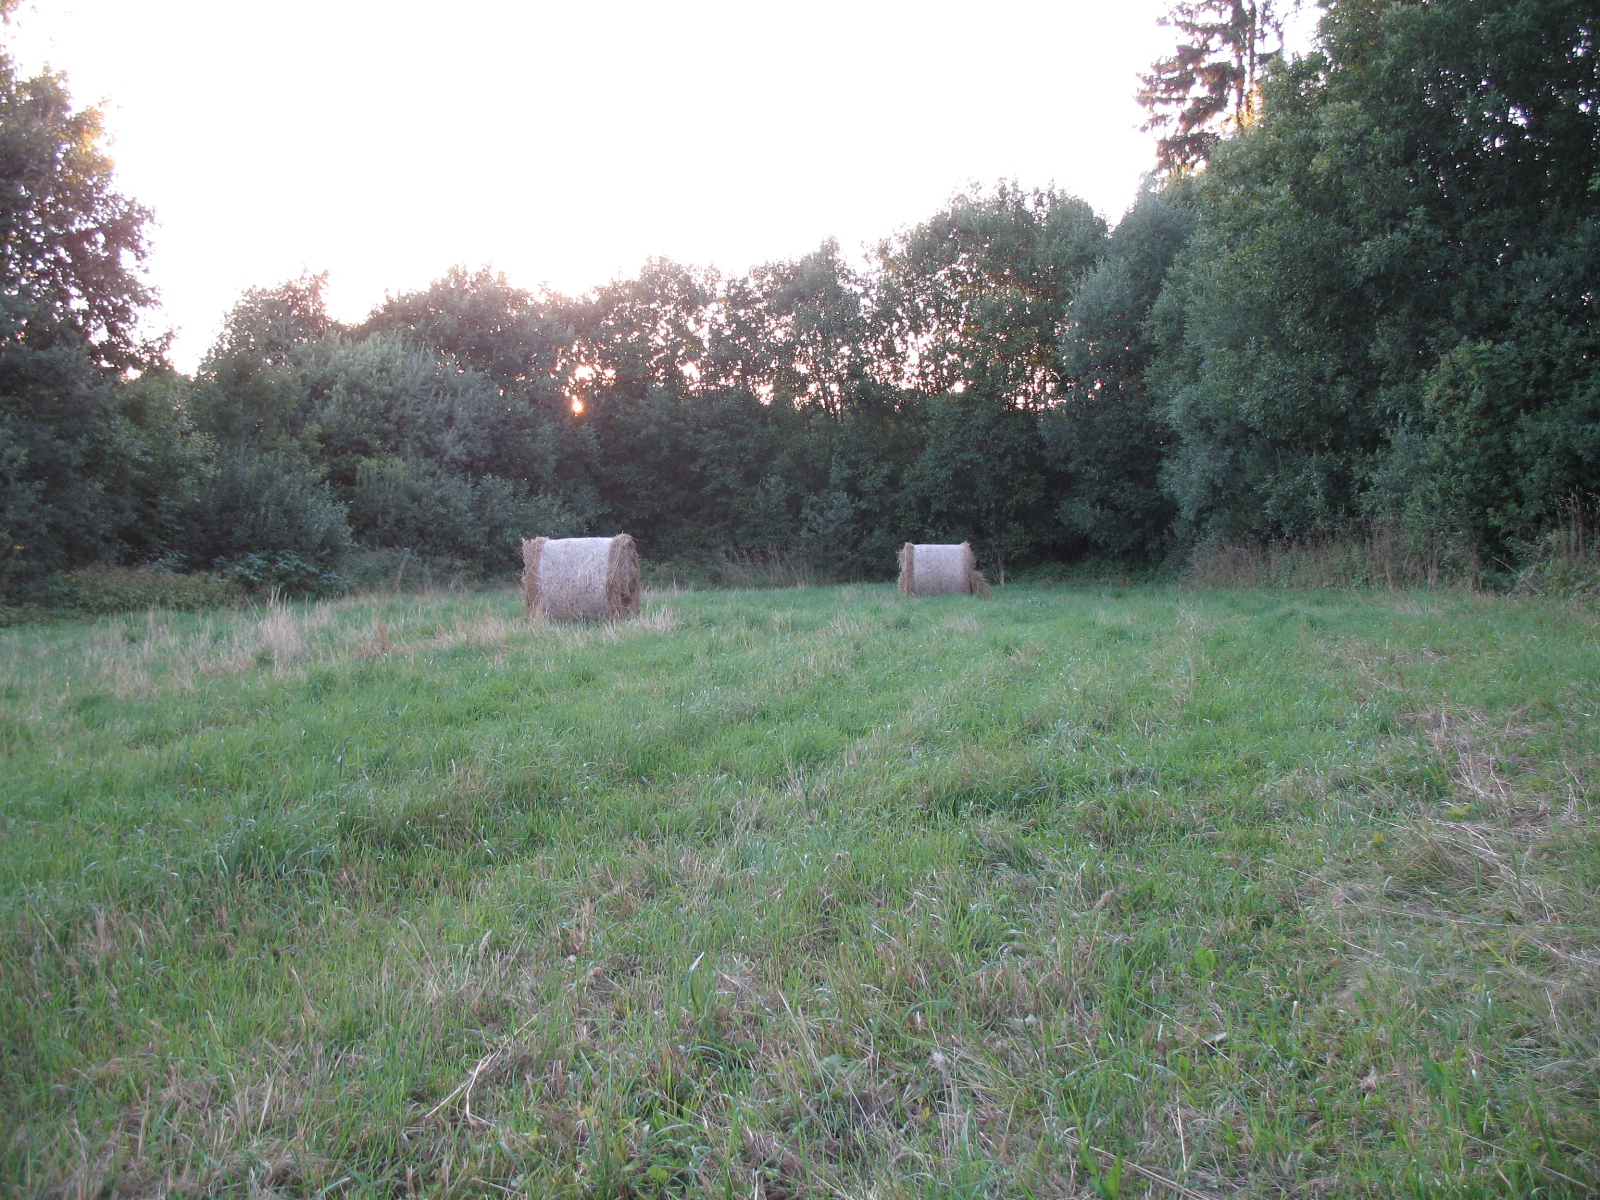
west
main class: Grassland
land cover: Grassland without tree/shrub cover
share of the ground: > 75 %
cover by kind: herbaceous plants 95 %, unconsolidated bare surface 5 %
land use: Agriculture (excluding fallow land and kitchen gardens)
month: August
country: LV
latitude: 56.5925
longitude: 25.6765
